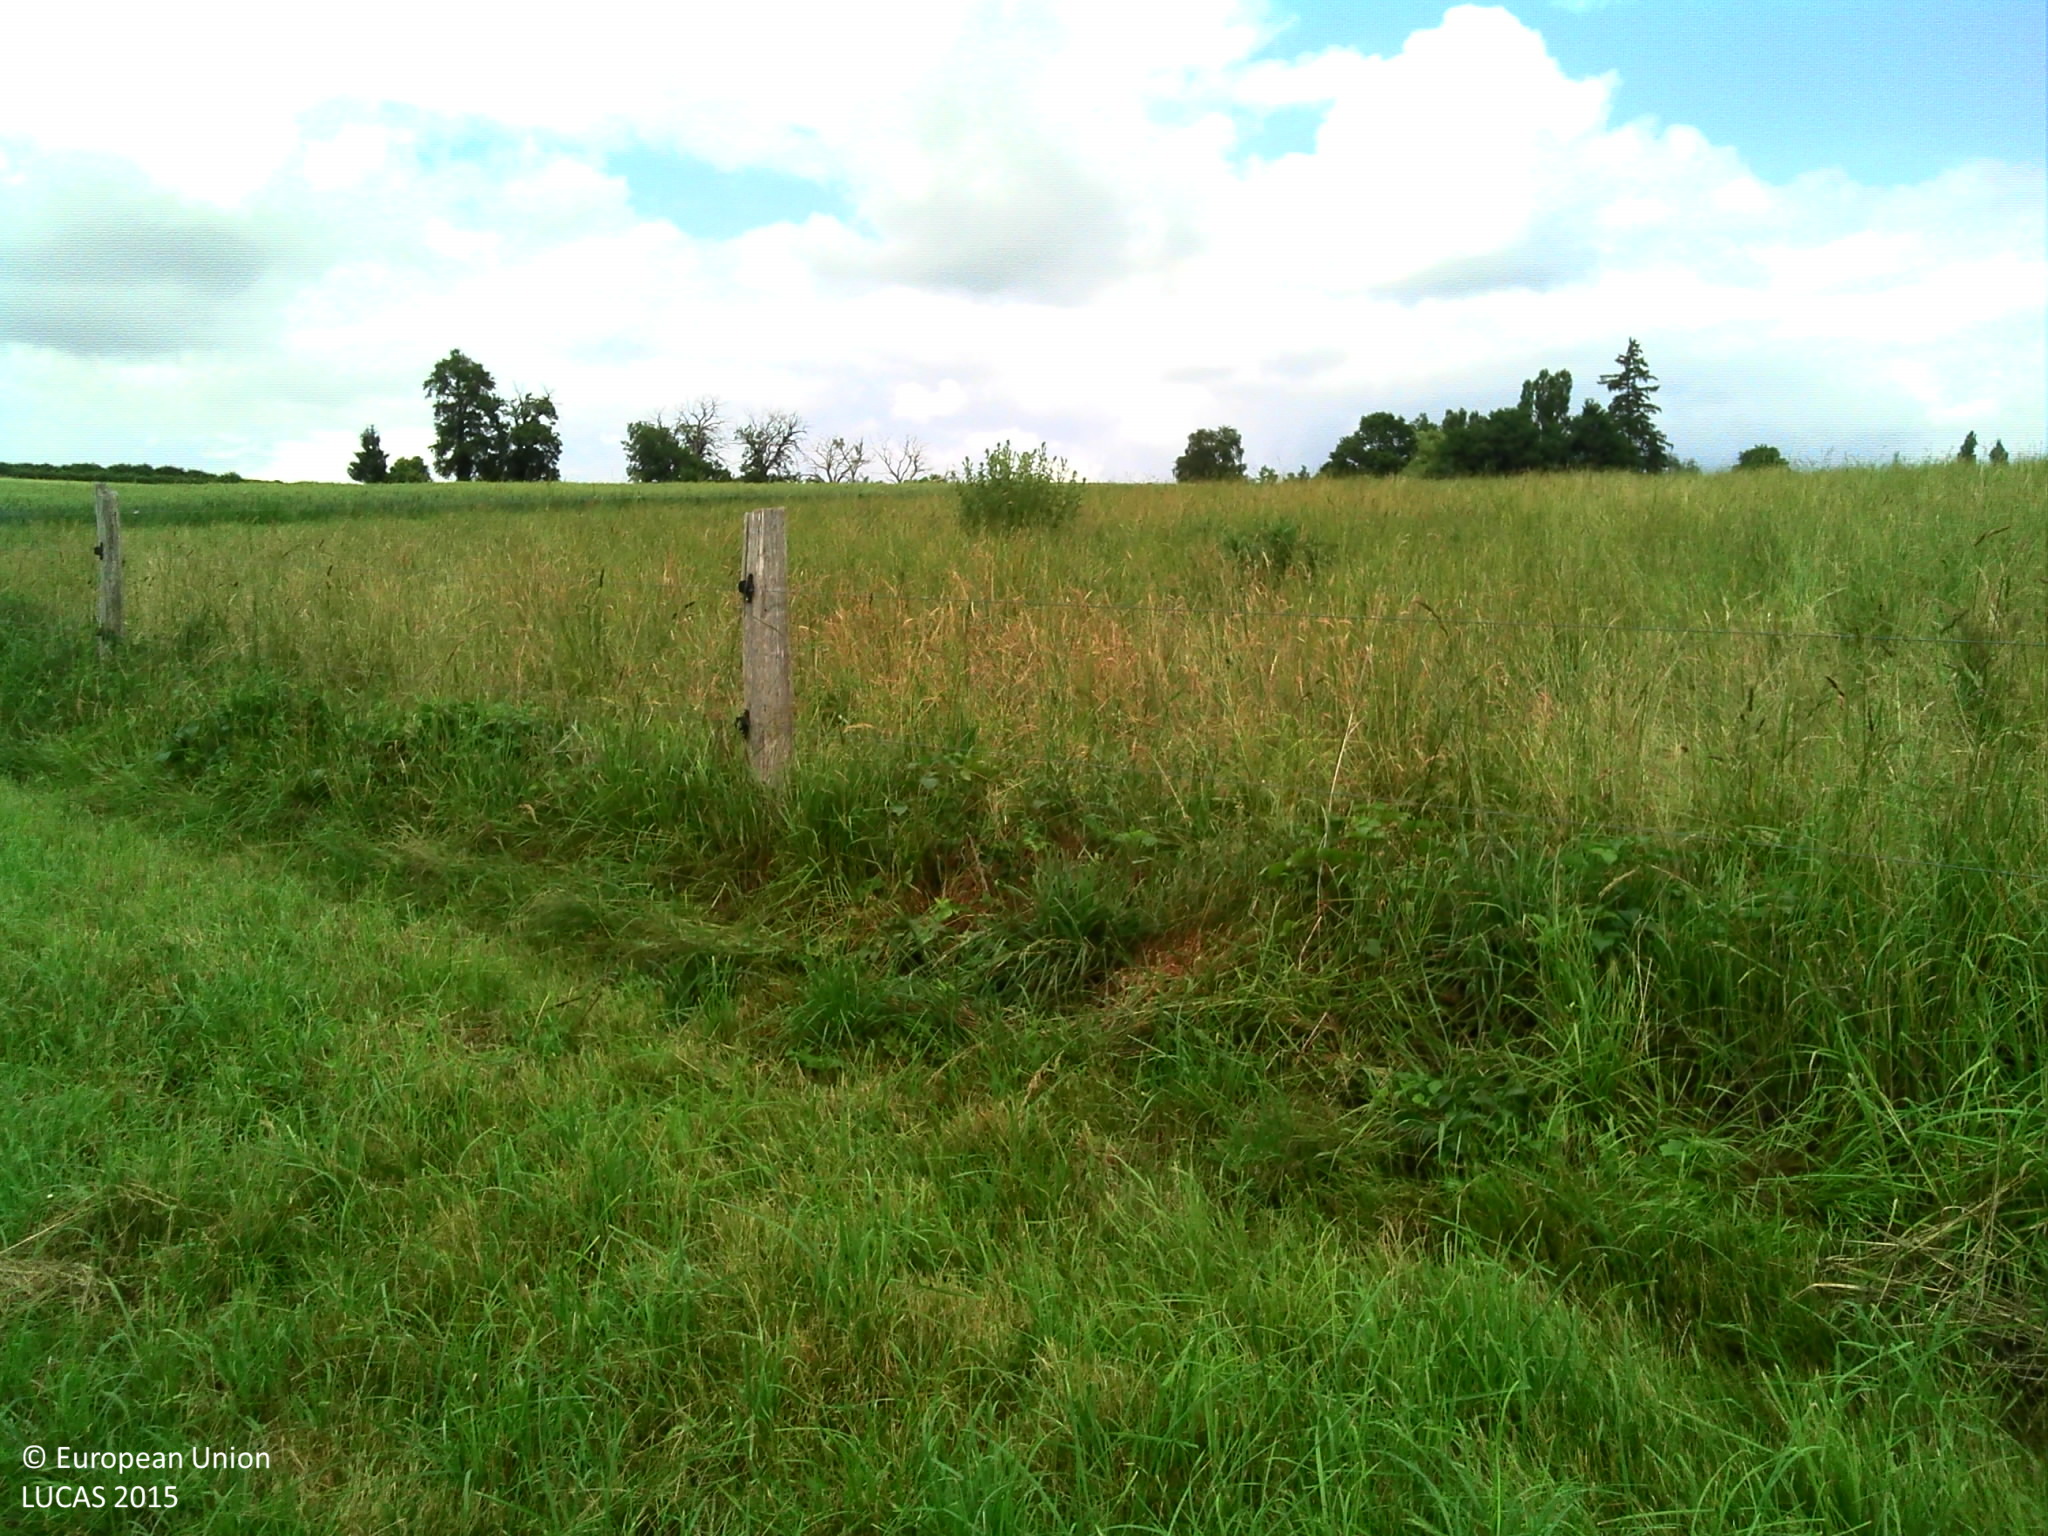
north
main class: Cropland
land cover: Temporary grasslands
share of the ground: > 75 %
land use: Agriculture (excluding fallow land and kitchen gardens)
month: June
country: FR
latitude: 44.2421
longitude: 2.5030
